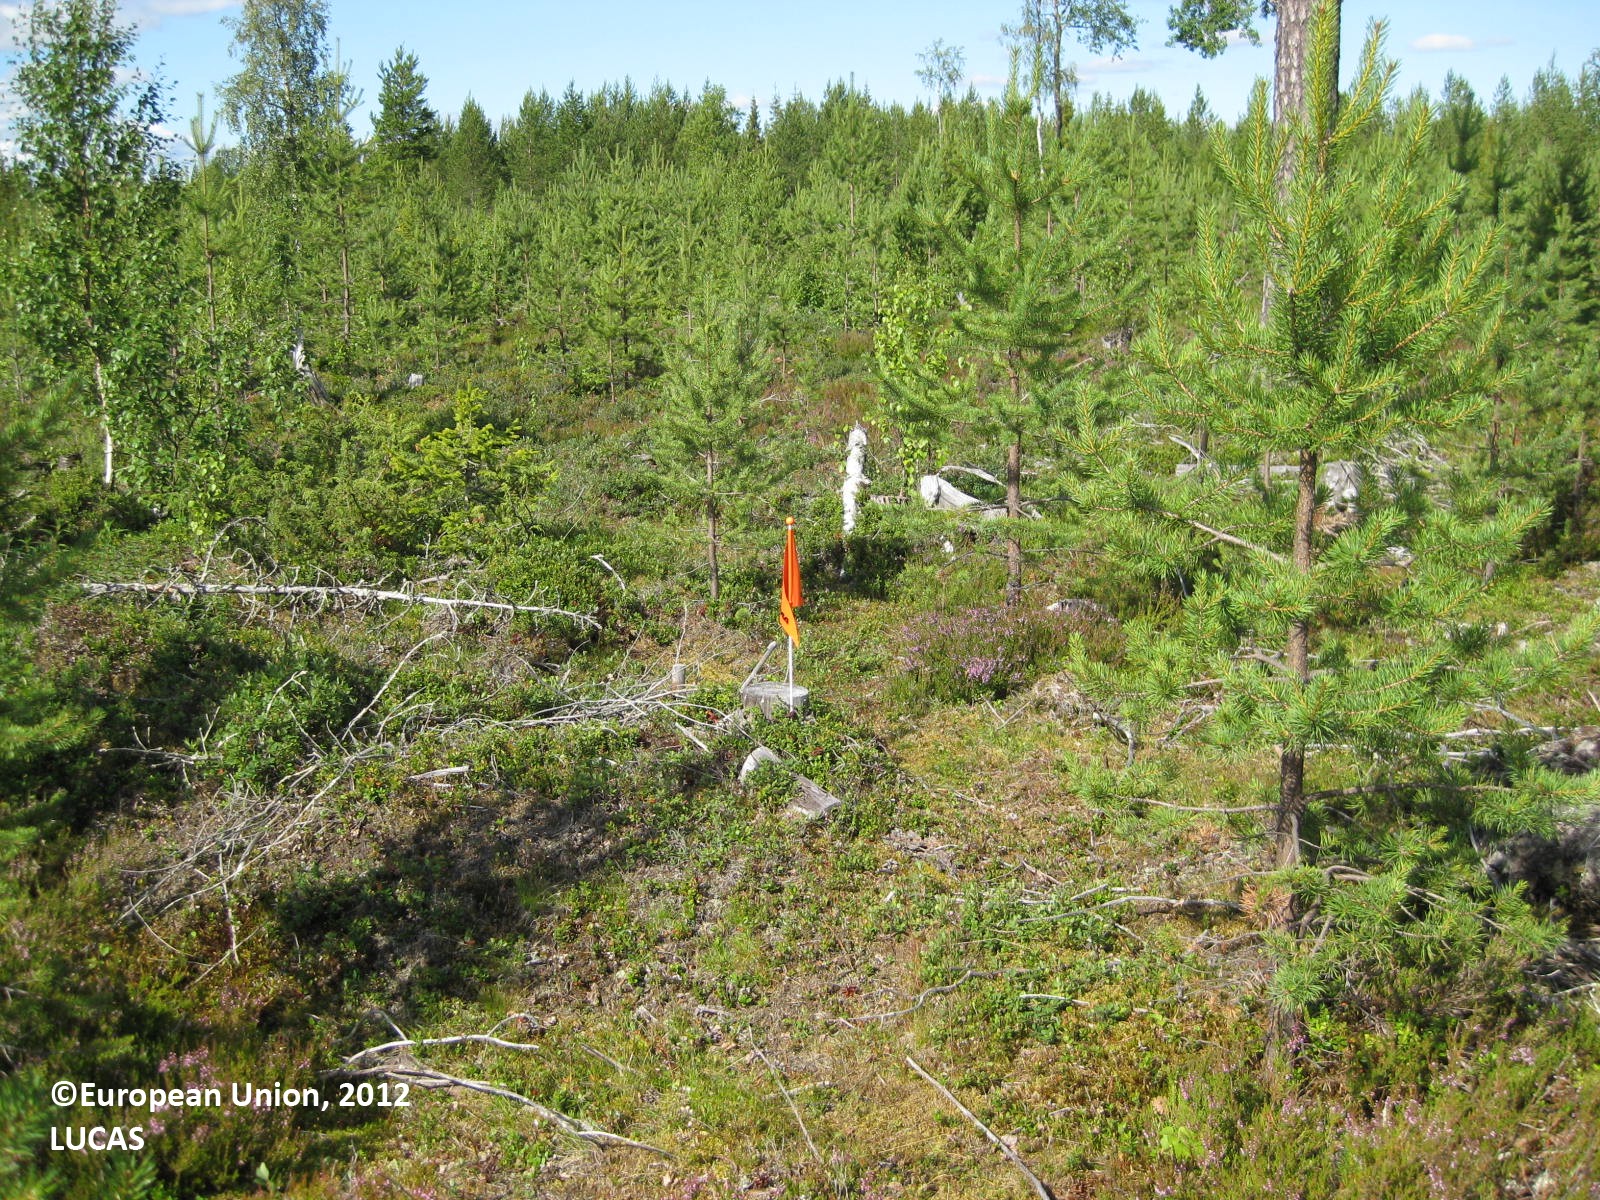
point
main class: Woodland
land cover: Pine dominated mixed woodland
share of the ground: 50 - 75 %
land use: Forestry
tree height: < 5 m
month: July
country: FI
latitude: 65.6735
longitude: 28.4539
